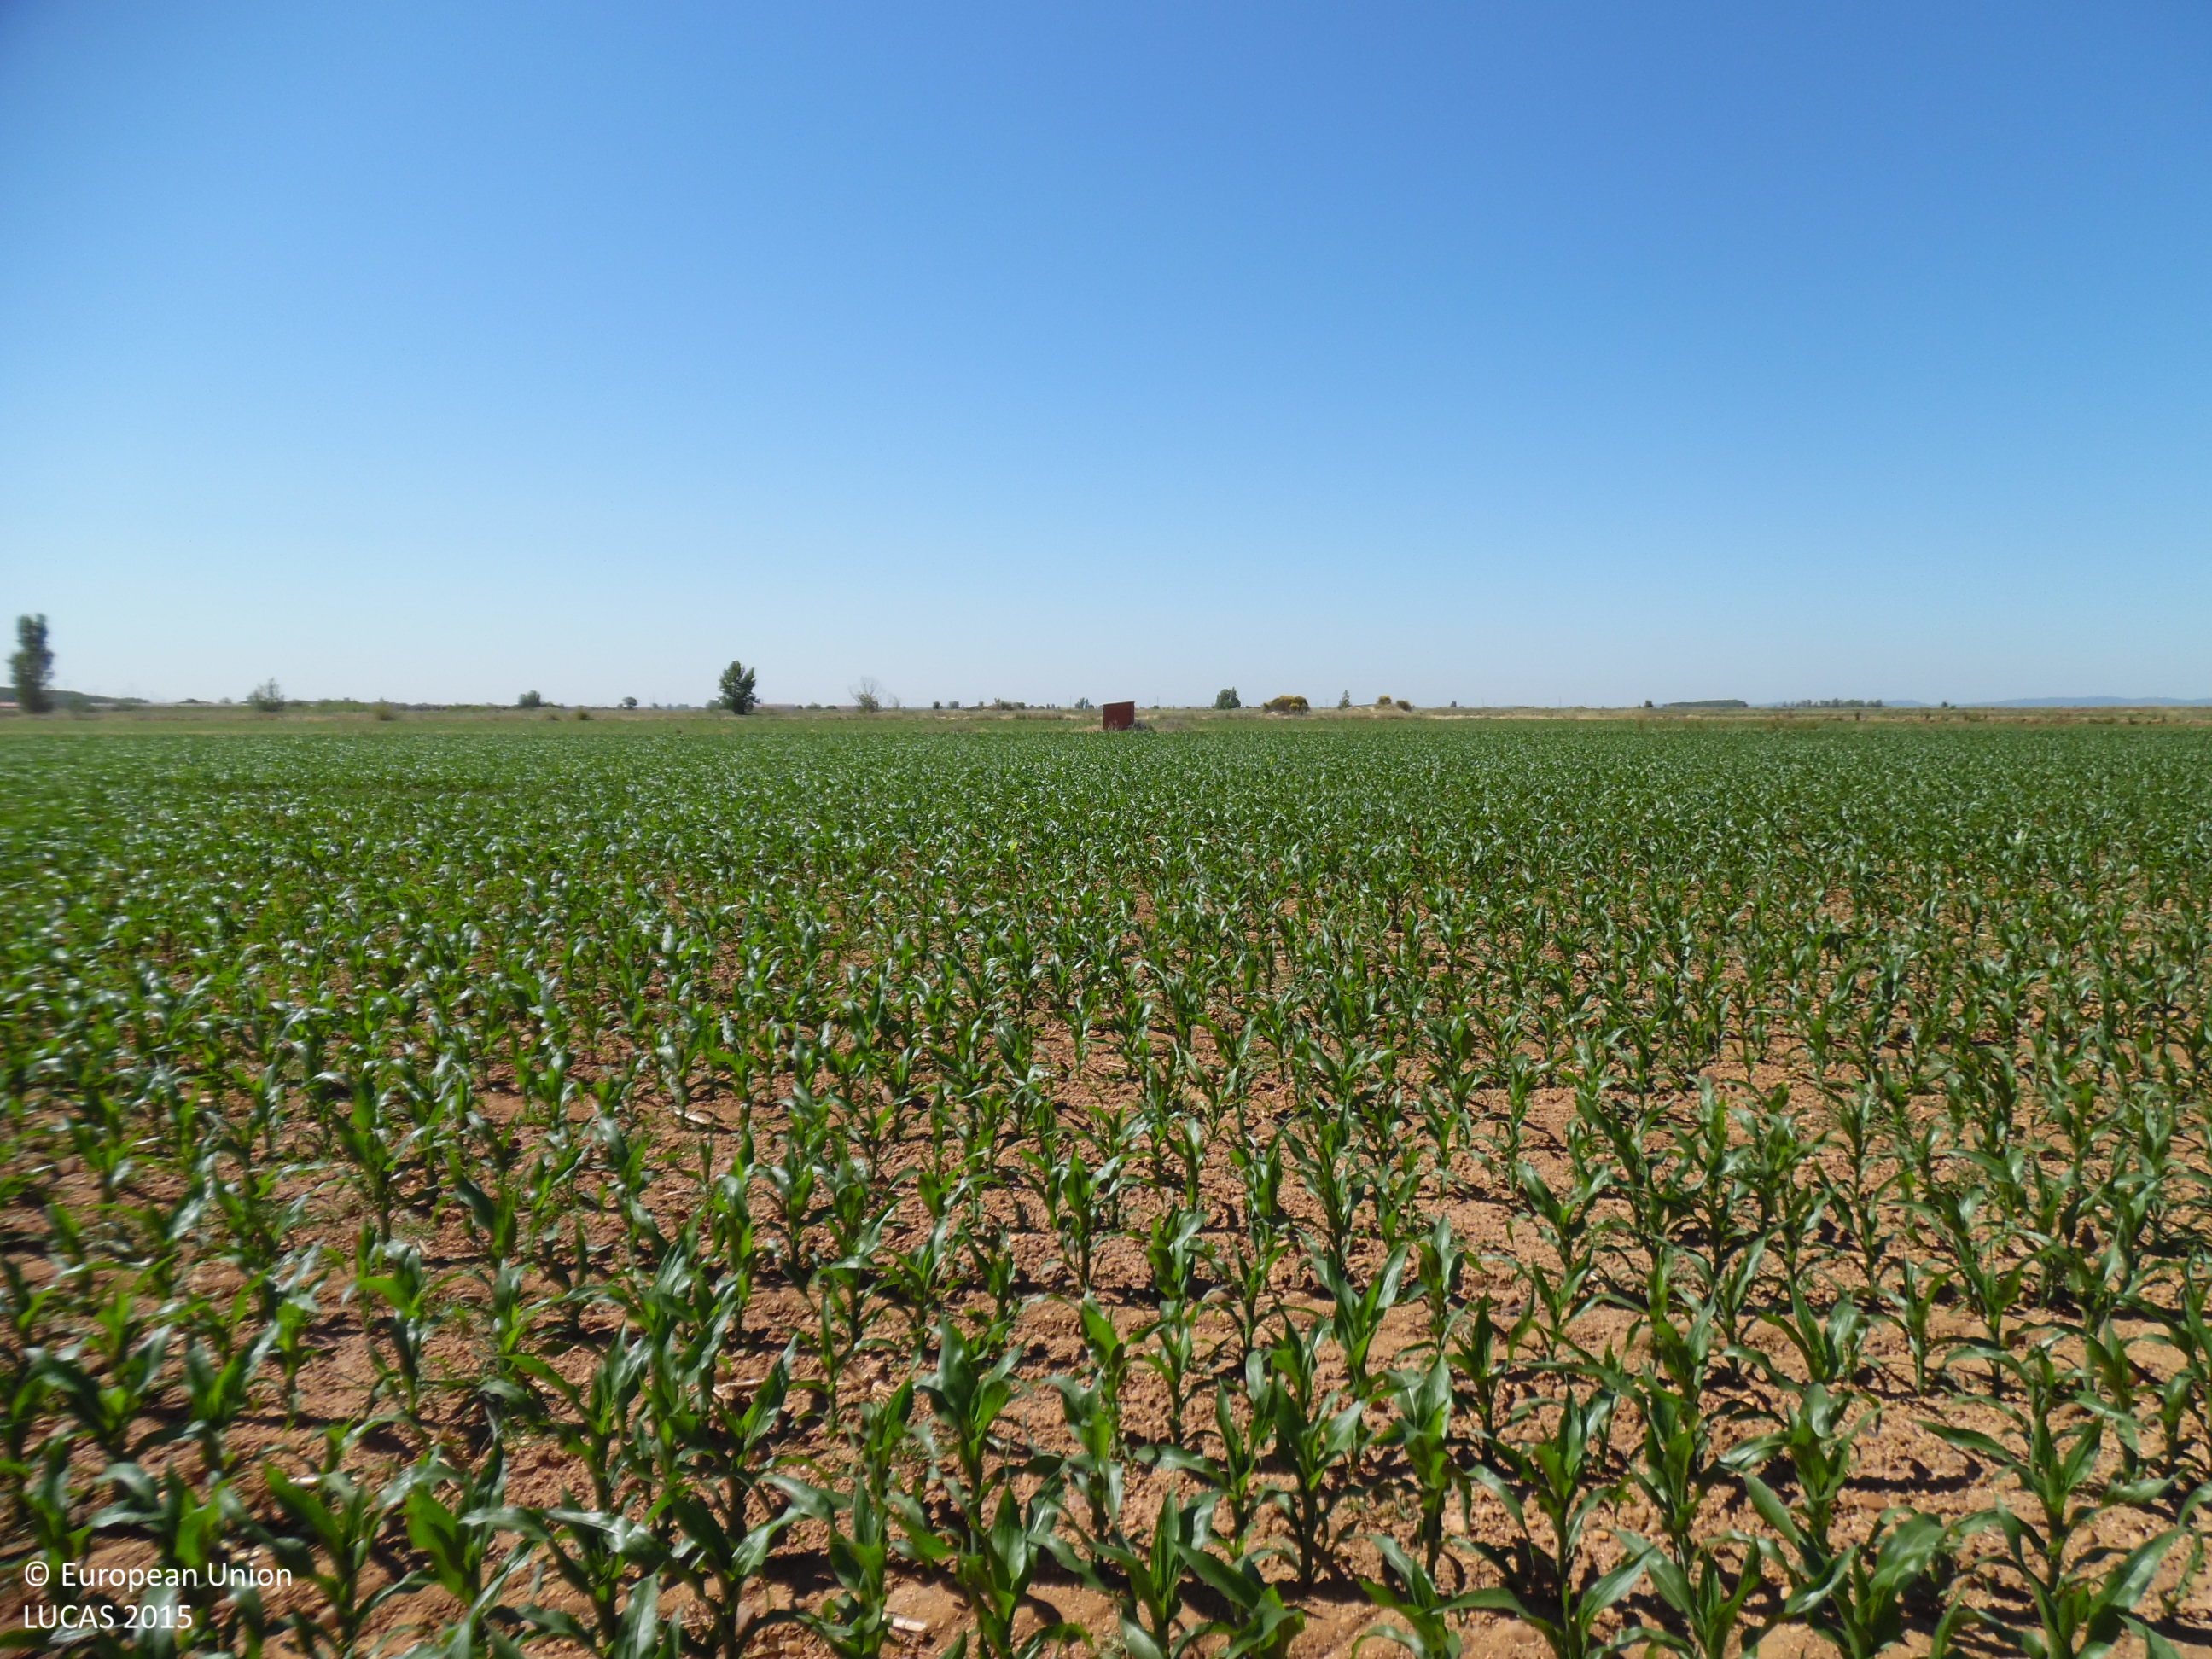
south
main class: Cropland
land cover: Maize
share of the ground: 50 - 75 %
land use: Agriculture (excluding fallow land and kitchen gardens)
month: June
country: ES
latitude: 42.2694
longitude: -5.6746
